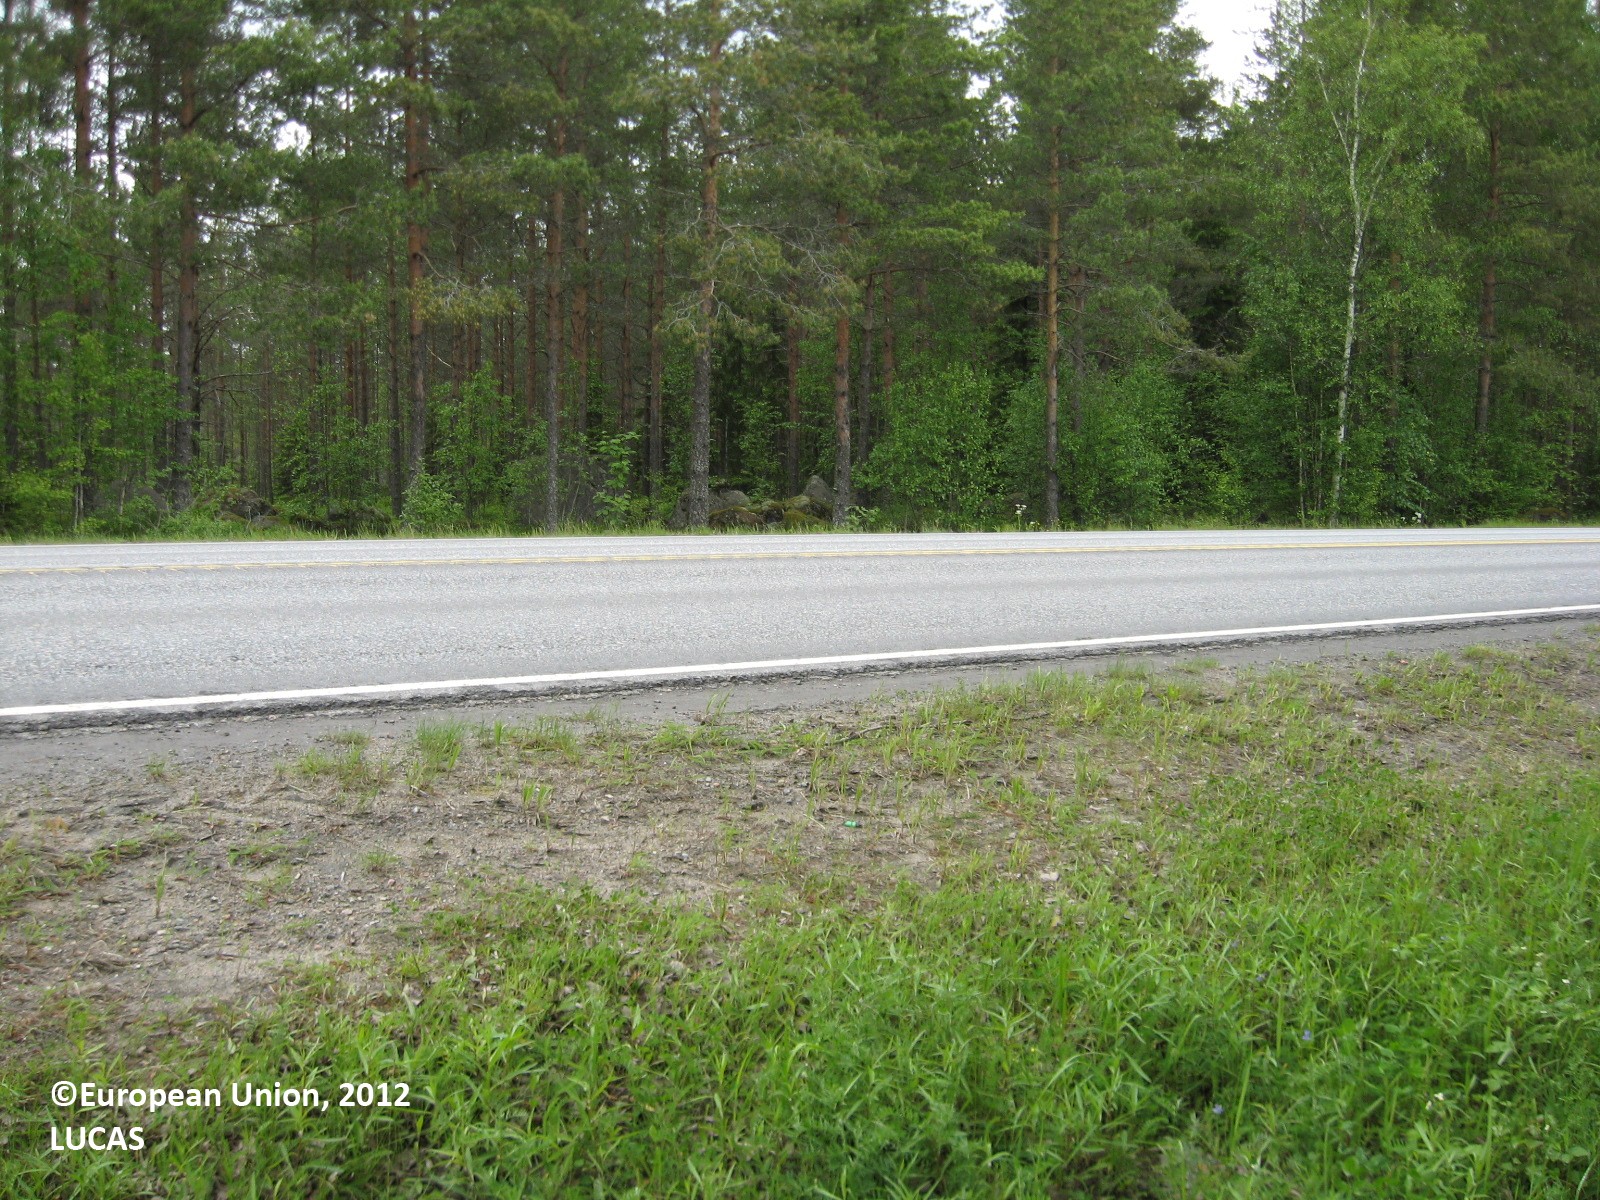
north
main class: Woodland
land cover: Spruce dominated mixed woodland
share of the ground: > 75 %
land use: Forestry
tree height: > 5 m
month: June
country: FI
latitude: 62.9826
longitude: 21.6236
